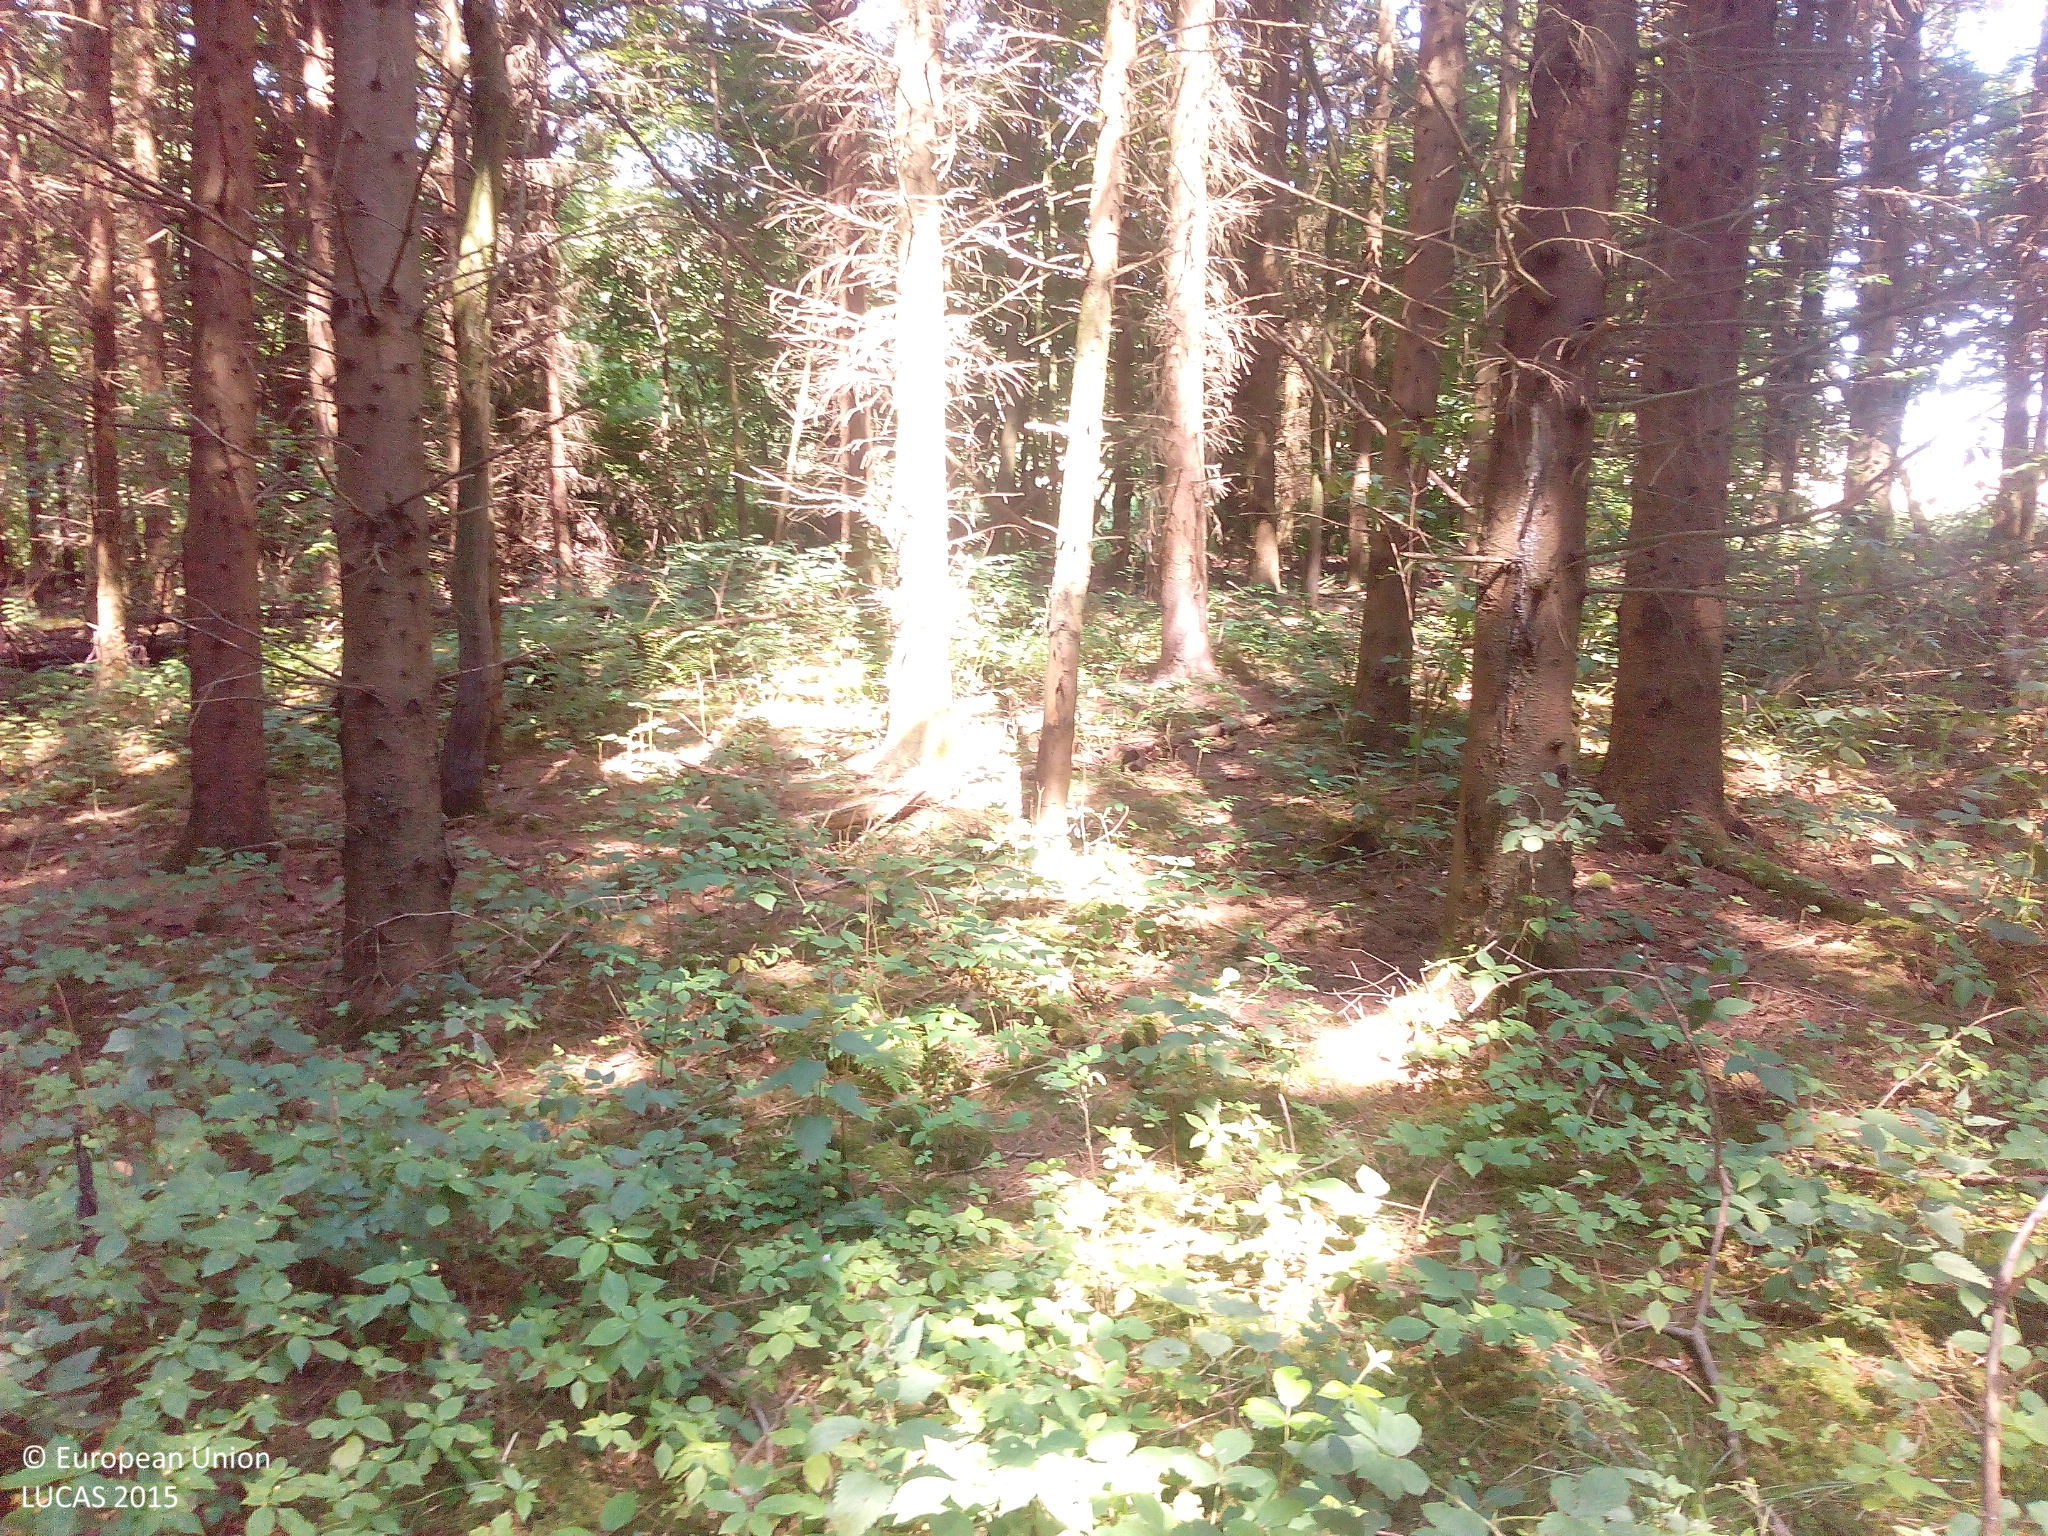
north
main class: Woodland
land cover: Spruce dominated coniferous woodland
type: hemiboreal forest and nemoral coniferous forest and mixed broadleaved-coniferous forest
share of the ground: > 75 %
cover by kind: coniferous forest trees 95 %, herbaceous plants 5 %
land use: Forestry
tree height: > 5 m
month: August
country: DE
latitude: 53.6466
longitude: 12.4651
